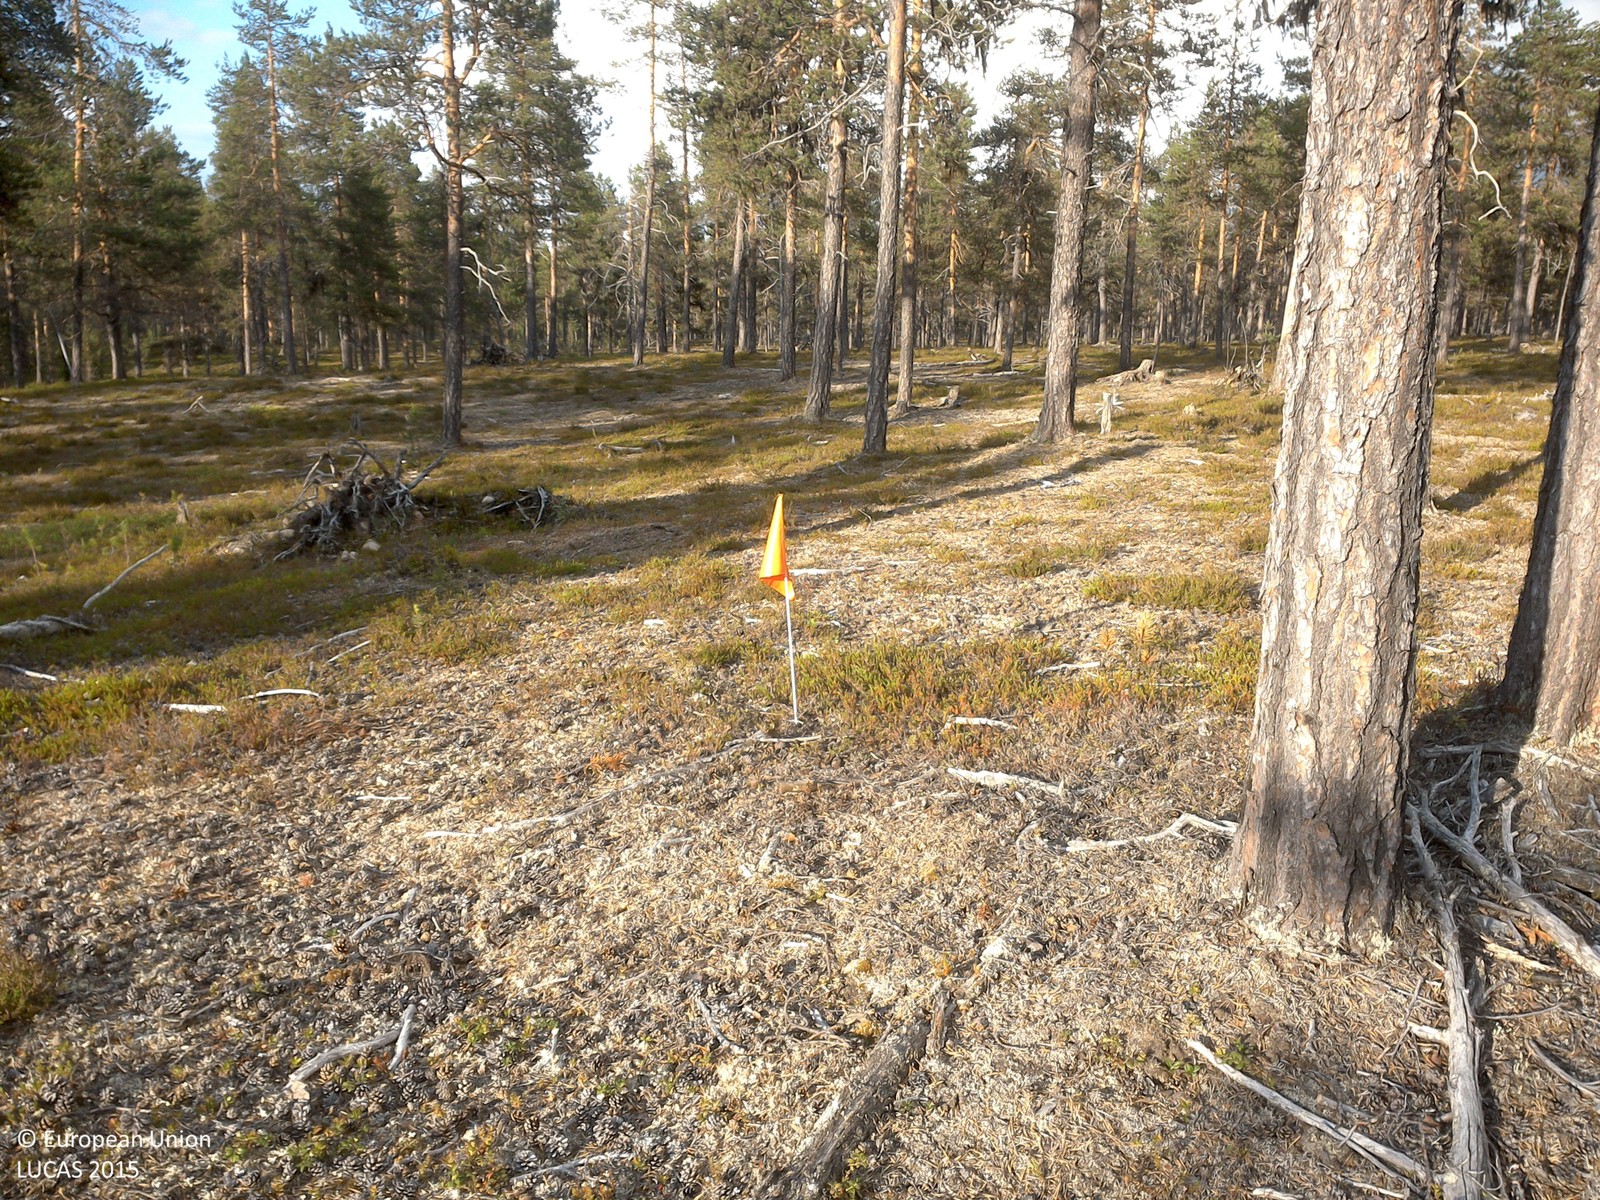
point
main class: Woodland
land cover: Pine dominated coniferous woodland
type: boreal forest
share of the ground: 10 - 25 %
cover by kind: lichens and mosses 45 %, shrubs 35 %, coniferous forest trees 20 %
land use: Forestry
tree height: > 5 m
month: July
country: SE
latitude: 67.7465
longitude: 23.4282
